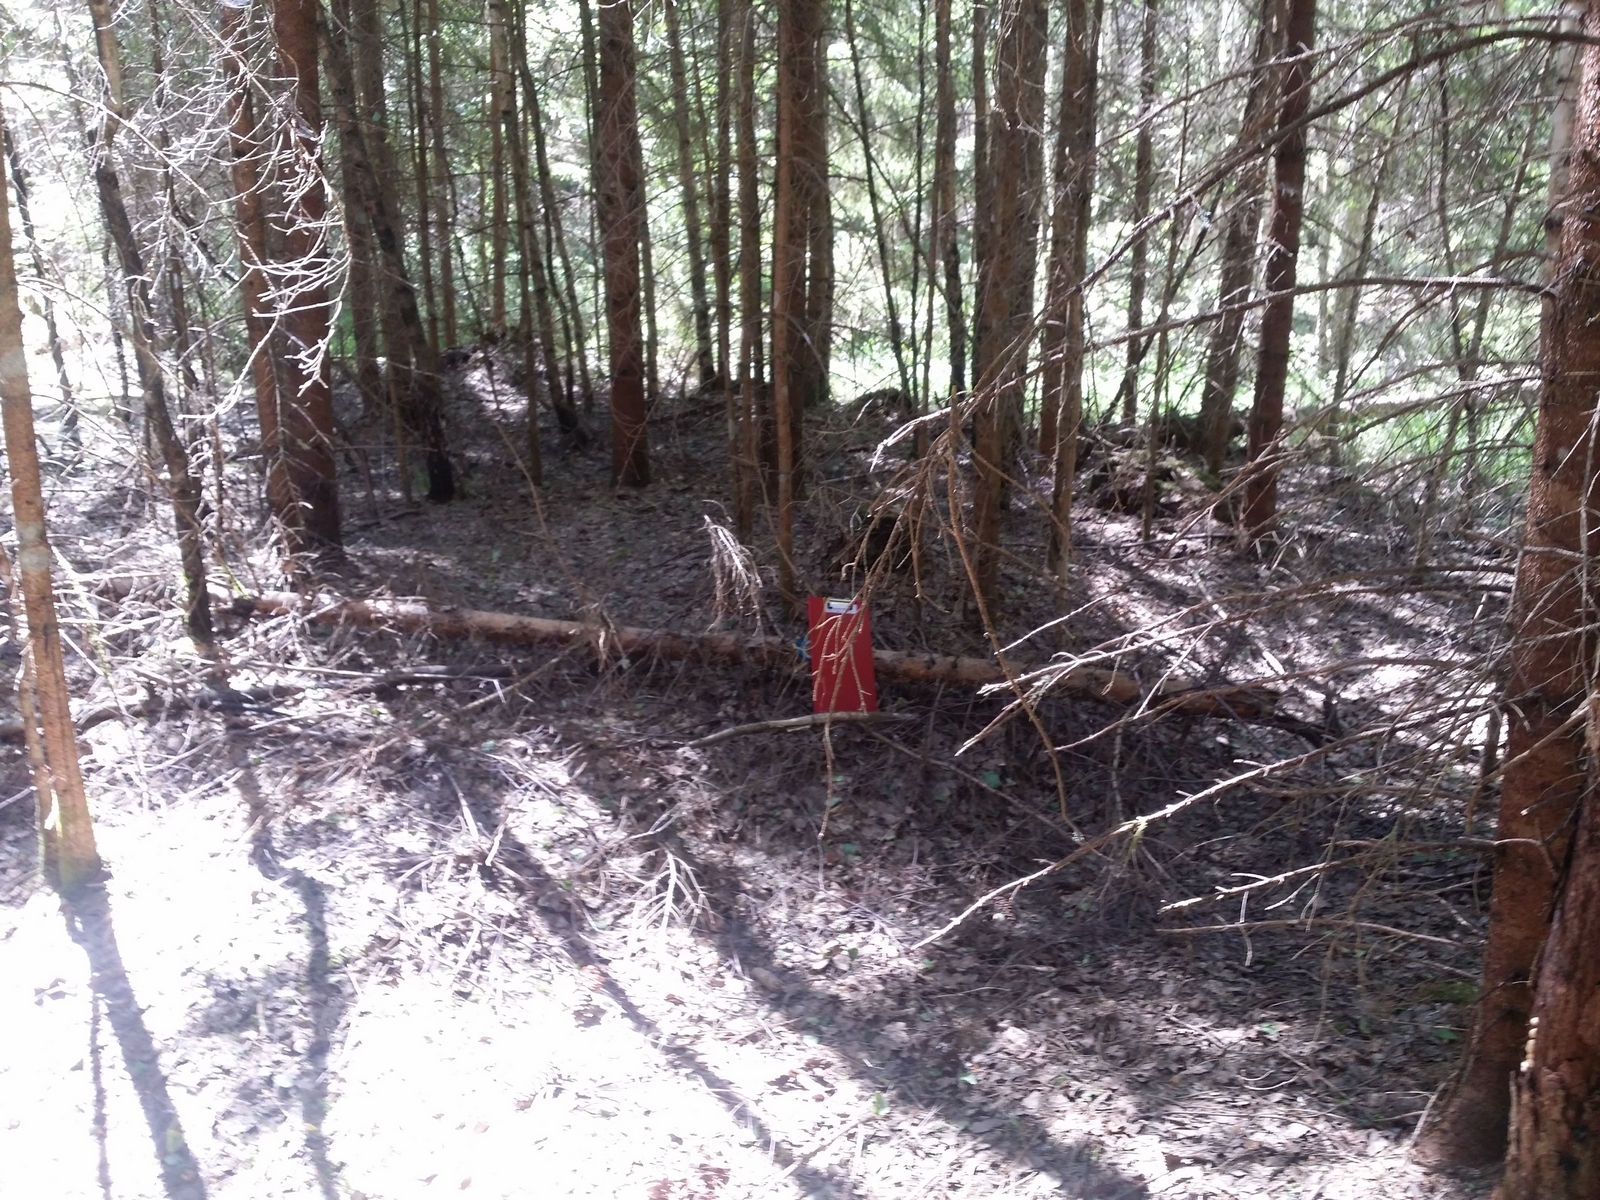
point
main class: Woodland
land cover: Spruce dominated coniferous woodland
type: hemiboreal forest and nemoral coniferous forest and mixed broadleaved-coniferous forest
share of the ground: > 75 %
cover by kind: coniferous forest trees 85 %, lichens and mosses 10 %, herbaceous plants 5 %
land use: Forestry
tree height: > 5 m
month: June
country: LV
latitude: 57.2736
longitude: 26.4108
